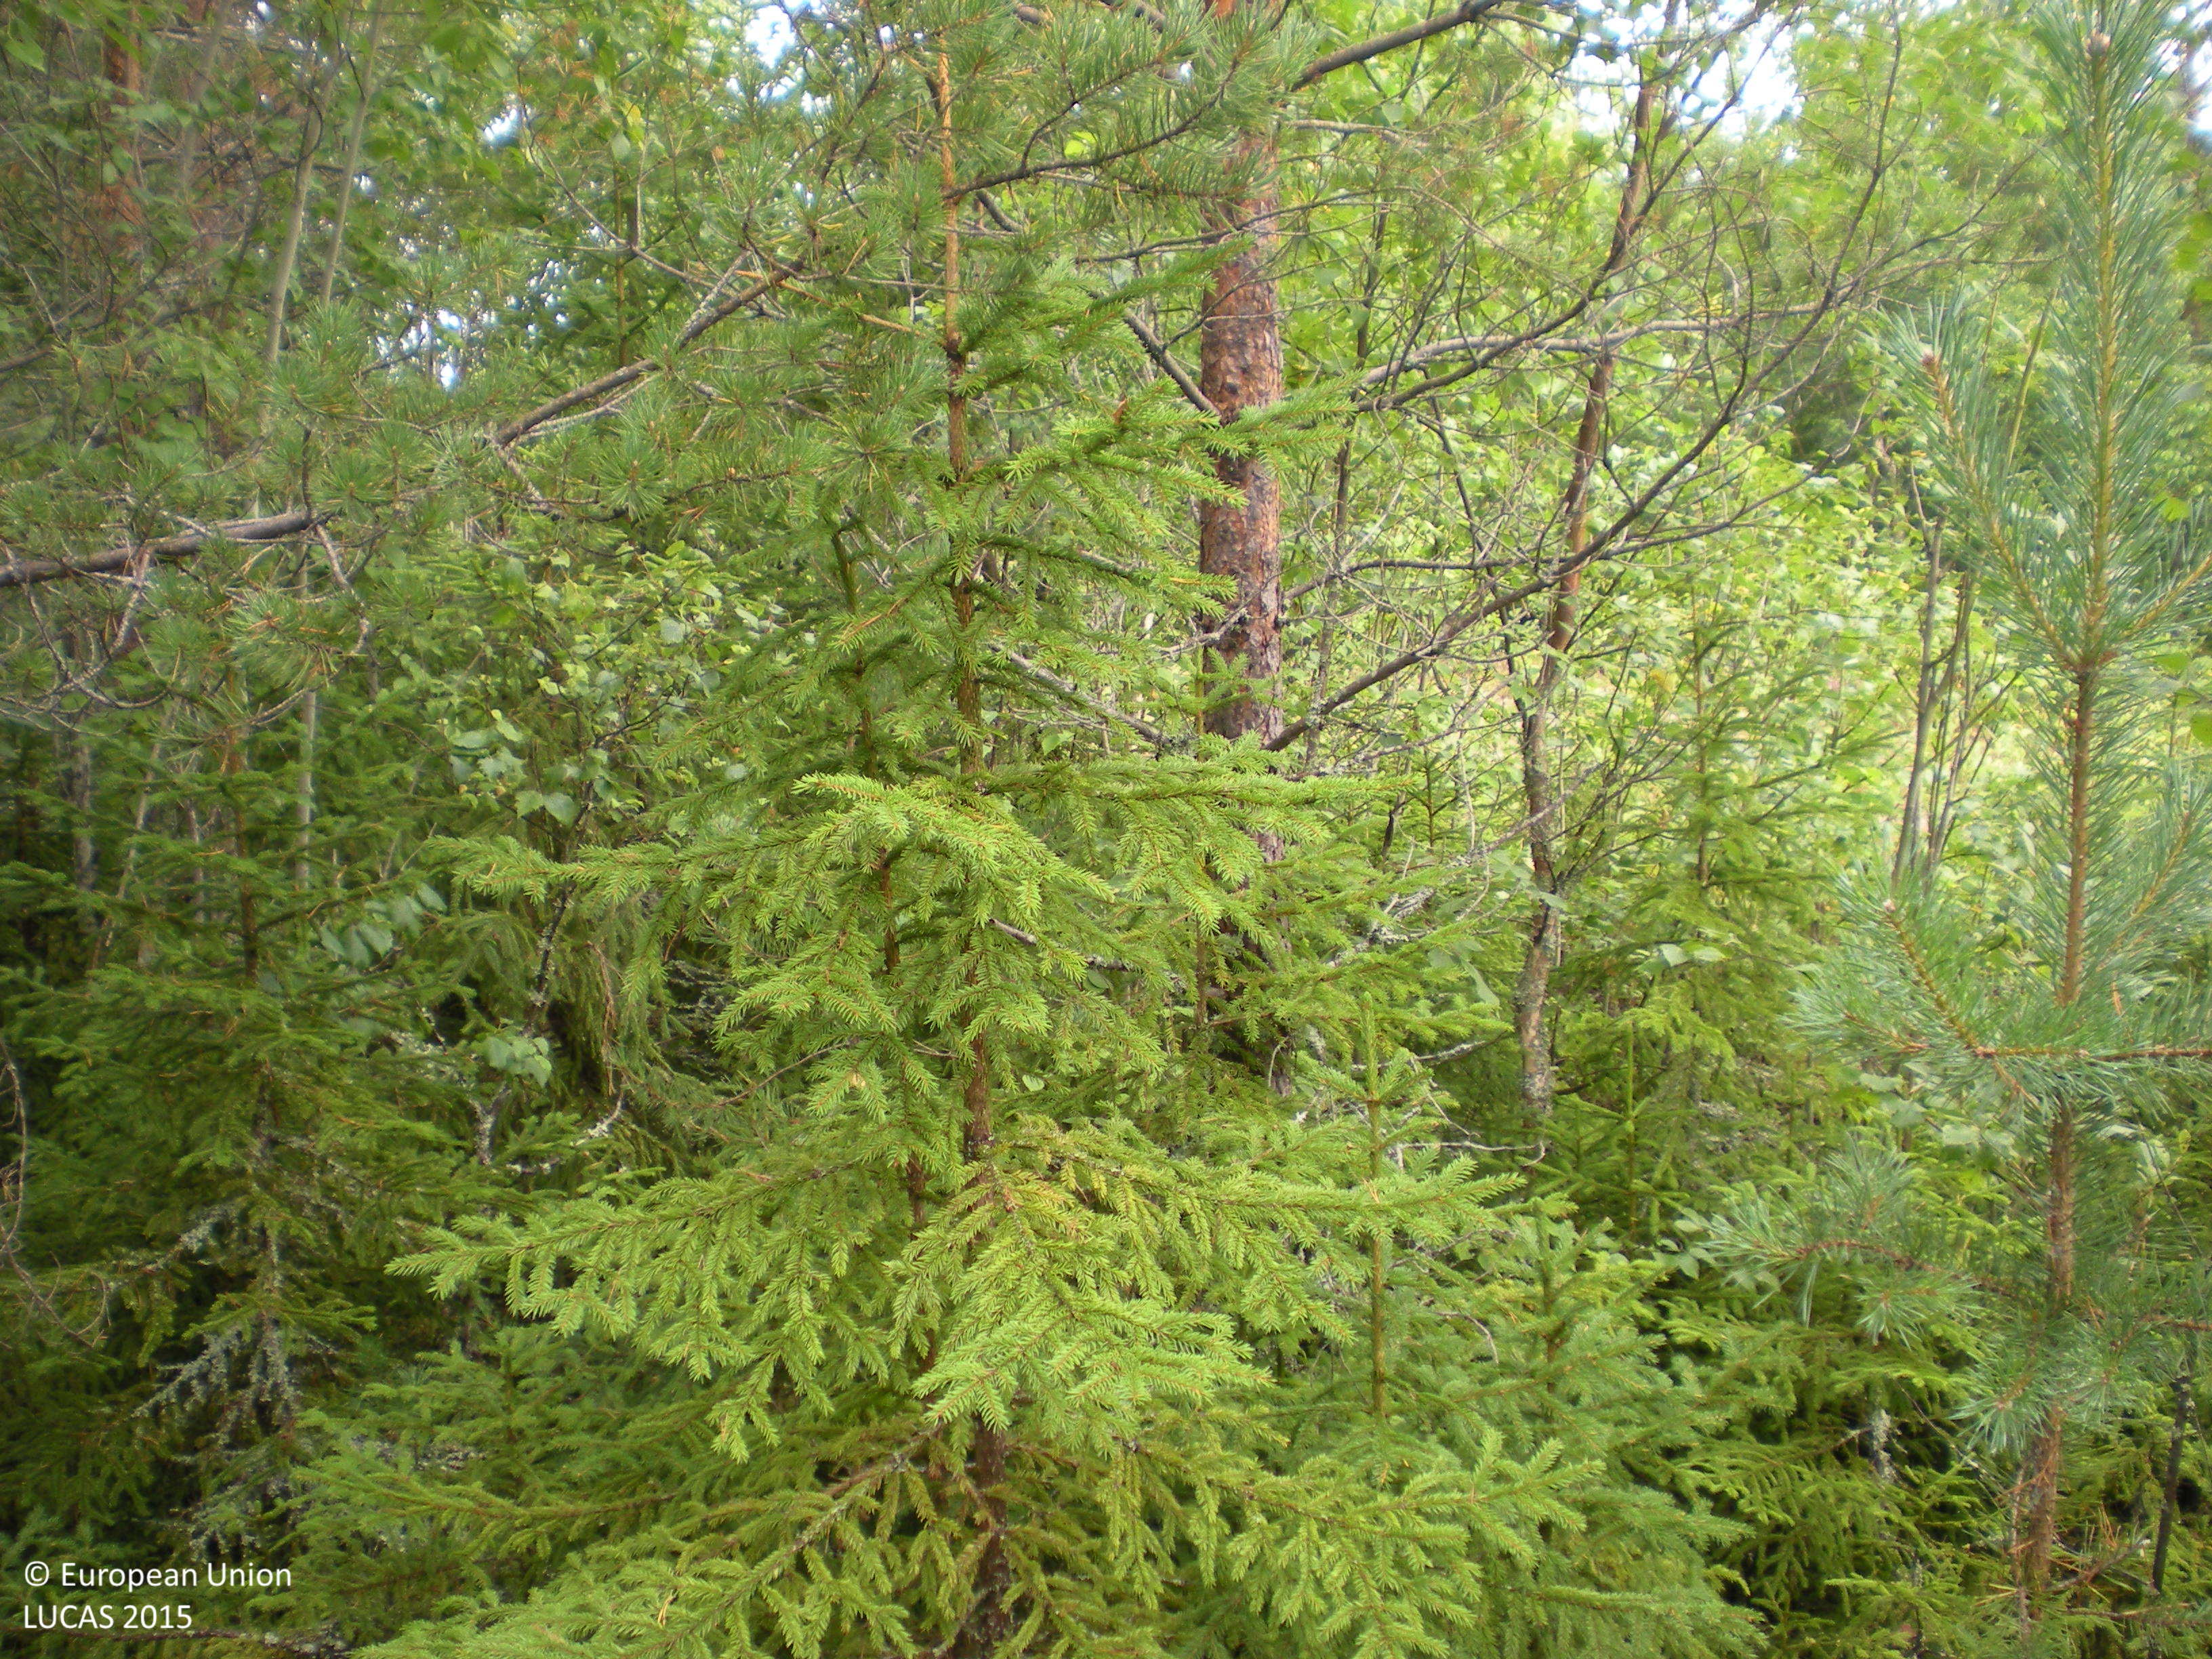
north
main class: Woodland
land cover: Pine dominated coniferous woodland
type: boreal forest
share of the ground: 50 - 75 %
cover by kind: coniferous forest trees 60 %, consolidated bare surface 15 %, lichens and mosses 10 %, broadleaved forest trees 5 %, shrubs 5 %, herbaceous plants 5 %
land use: Forestry
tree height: < 5 m
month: August
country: SE
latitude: 60.7708
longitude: 16.9093
